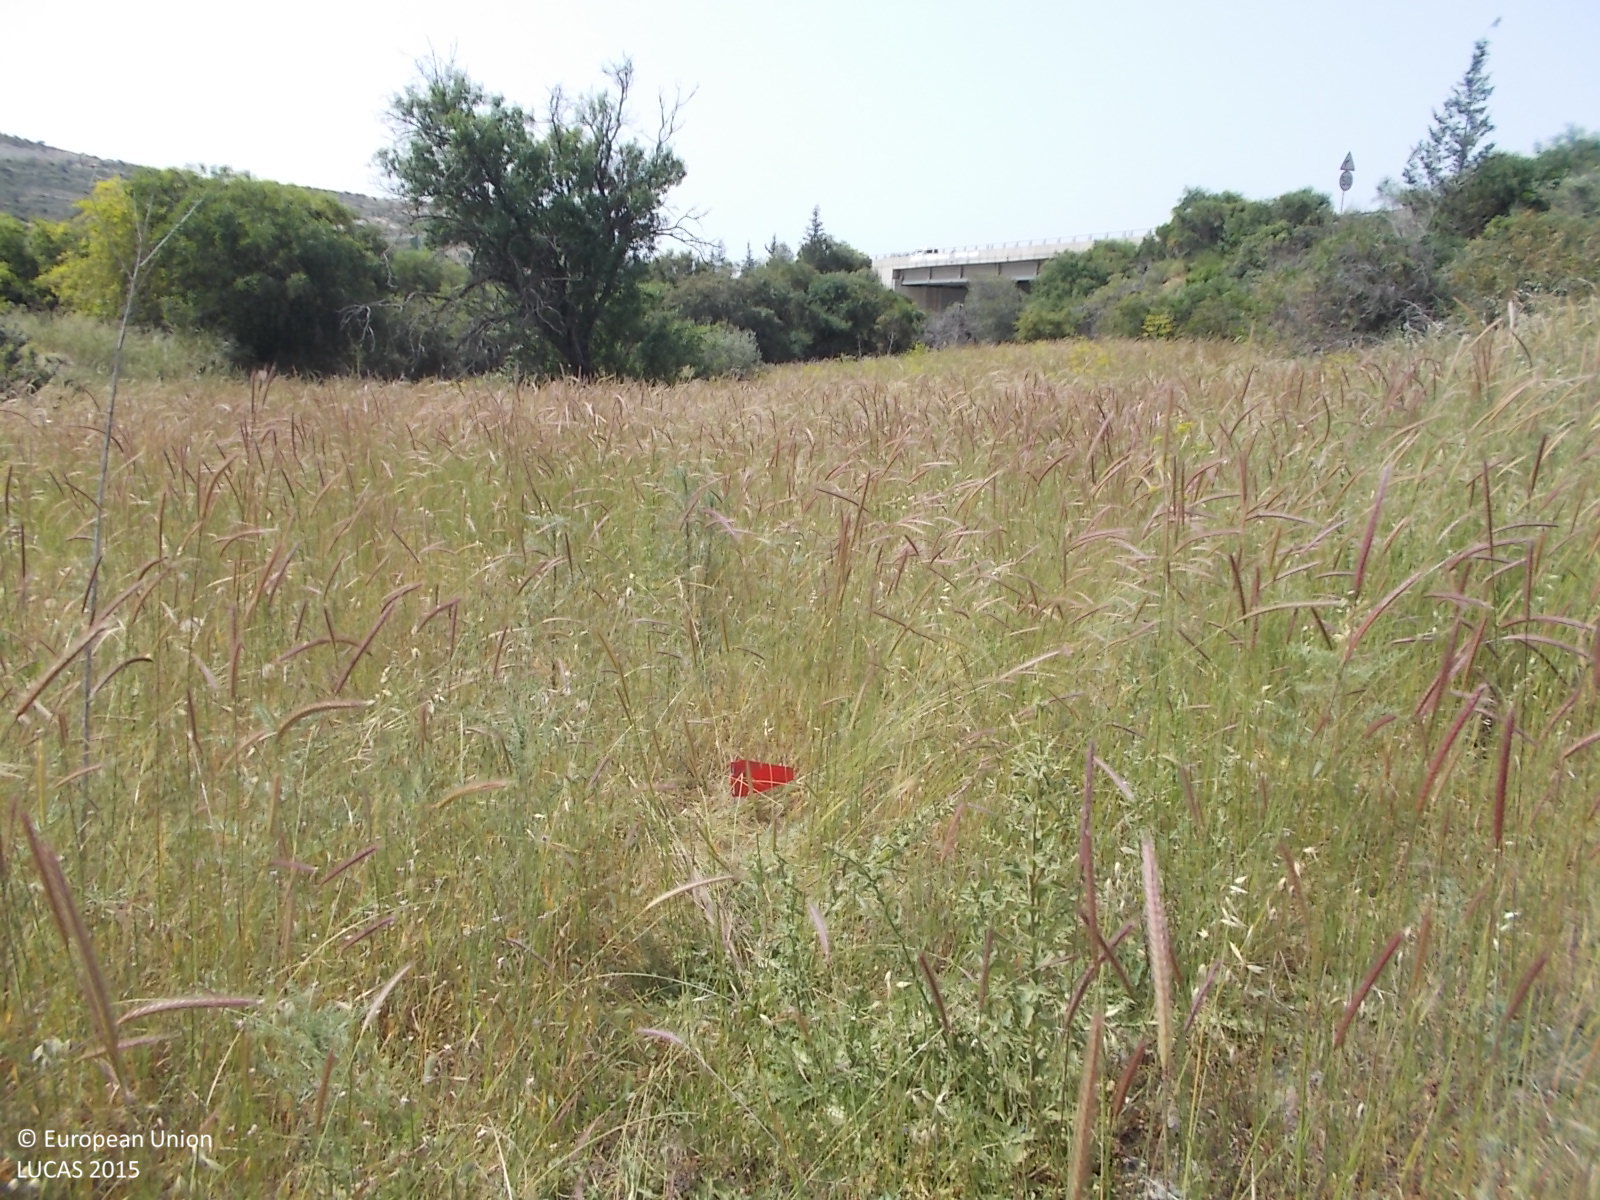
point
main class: Grassland
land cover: Spontaneously vegetated surfaces
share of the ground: > 75 %
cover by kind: herbaceous plants 100 %
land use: Semi-natural and natural areas not in use
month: April
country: CY
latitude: 34.7231
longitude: 33.2029
